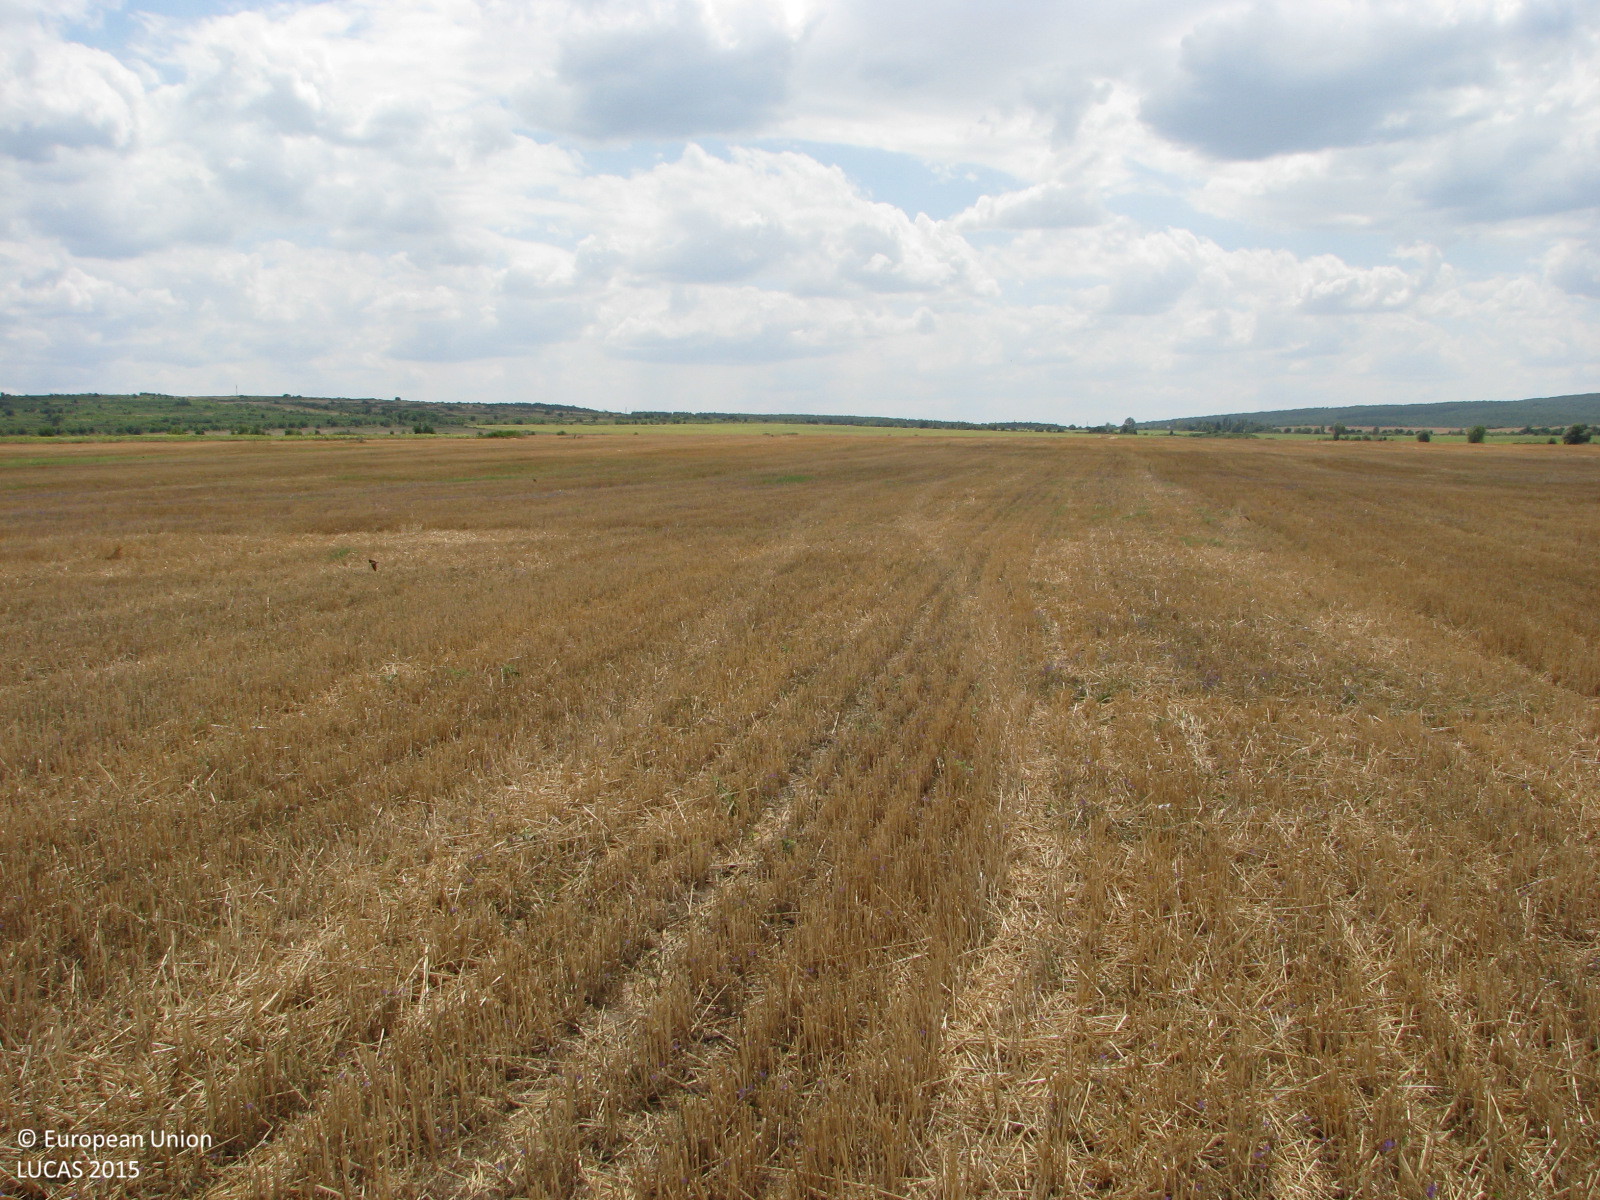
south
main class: Cropland
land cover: Common wheat
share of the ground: 50 - 75 %
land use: Agriculture (excluding fallow land and kitchen gardens)
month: August
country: BG
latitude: 42.7189
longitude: 26.6448
